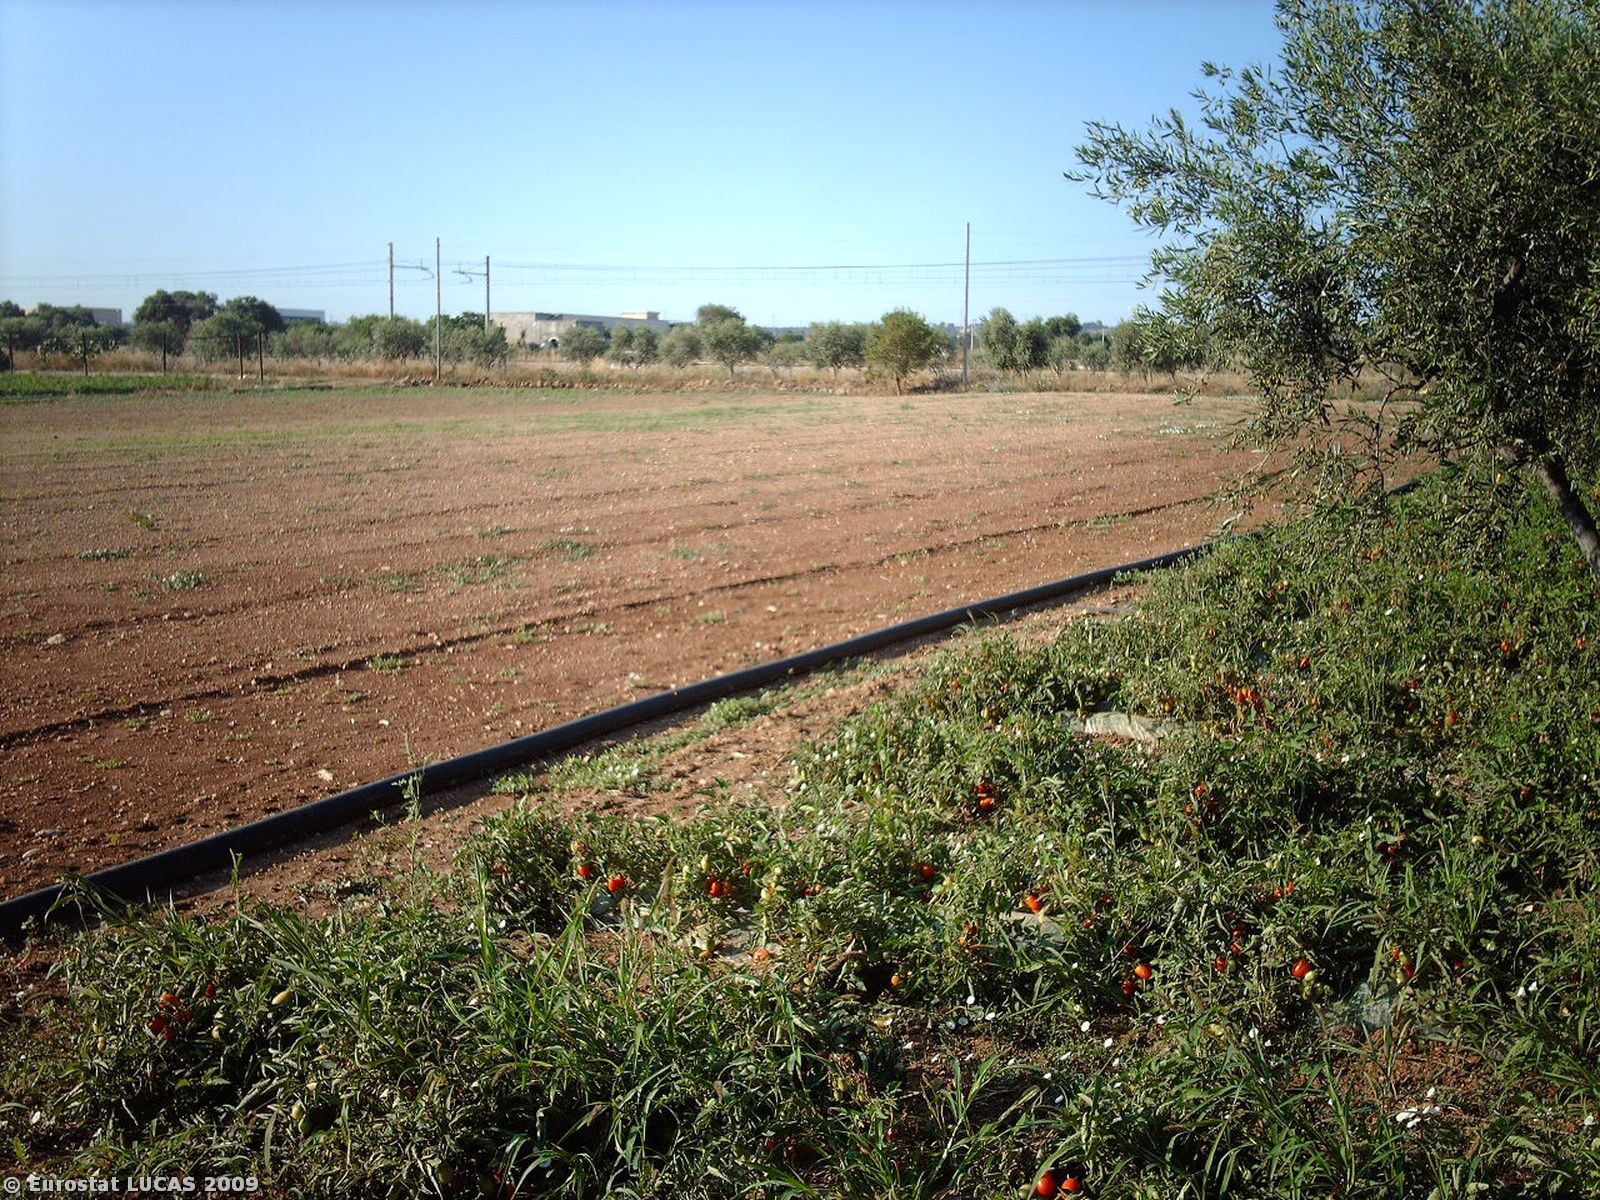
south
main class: Cropland
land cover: Olive groves
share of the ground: 25 - 50 %
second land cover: Spontaneously vegetated surfaces
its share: 50 - 75 %
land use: Agriculture (excluding fallow land and kitchen gardens)
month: July
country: IT
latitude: 41.0656
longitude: 17.0598
